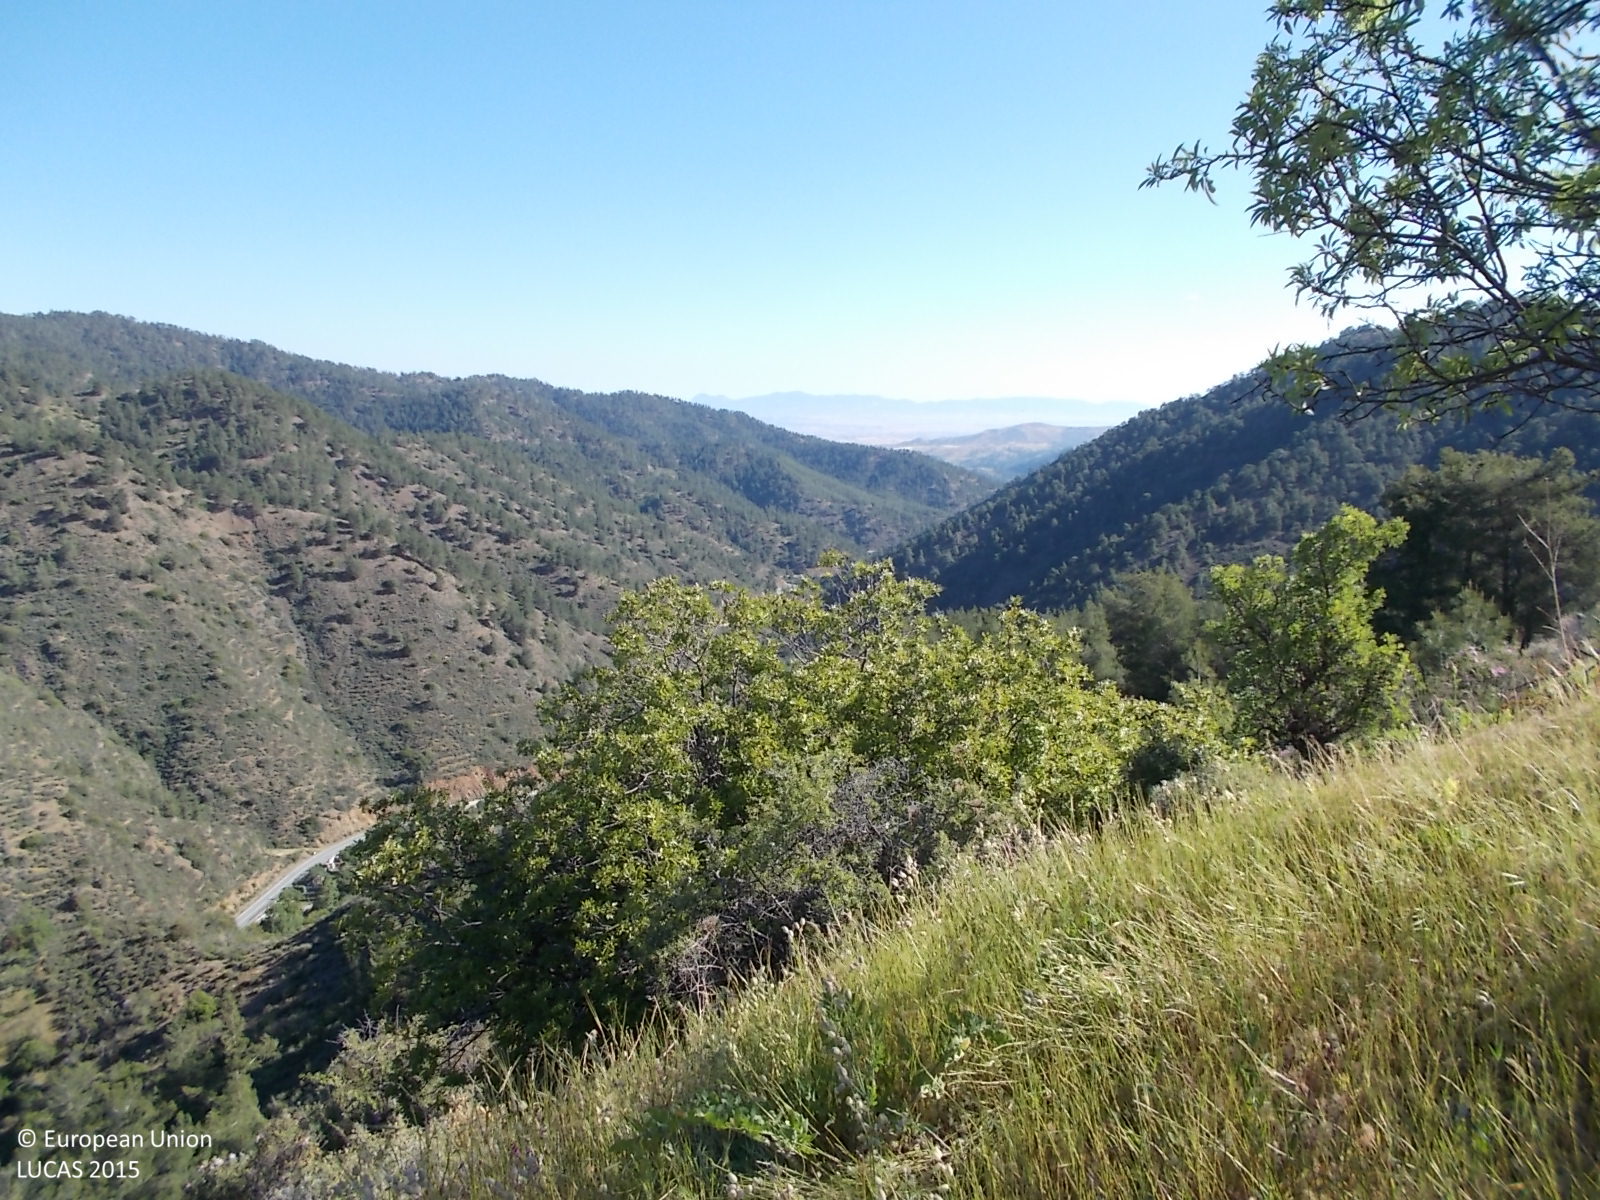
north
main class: Woodland
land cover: Pine dominated coniferous woodland
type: coniferous forest of the mediterranean region
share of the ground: > 75 %
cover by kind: coniferous forest trees 100 %
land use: Semi-natural and natural areas not in use
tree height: > 5 m
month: May
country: CY
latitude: 34.9676
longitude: 33.0545
